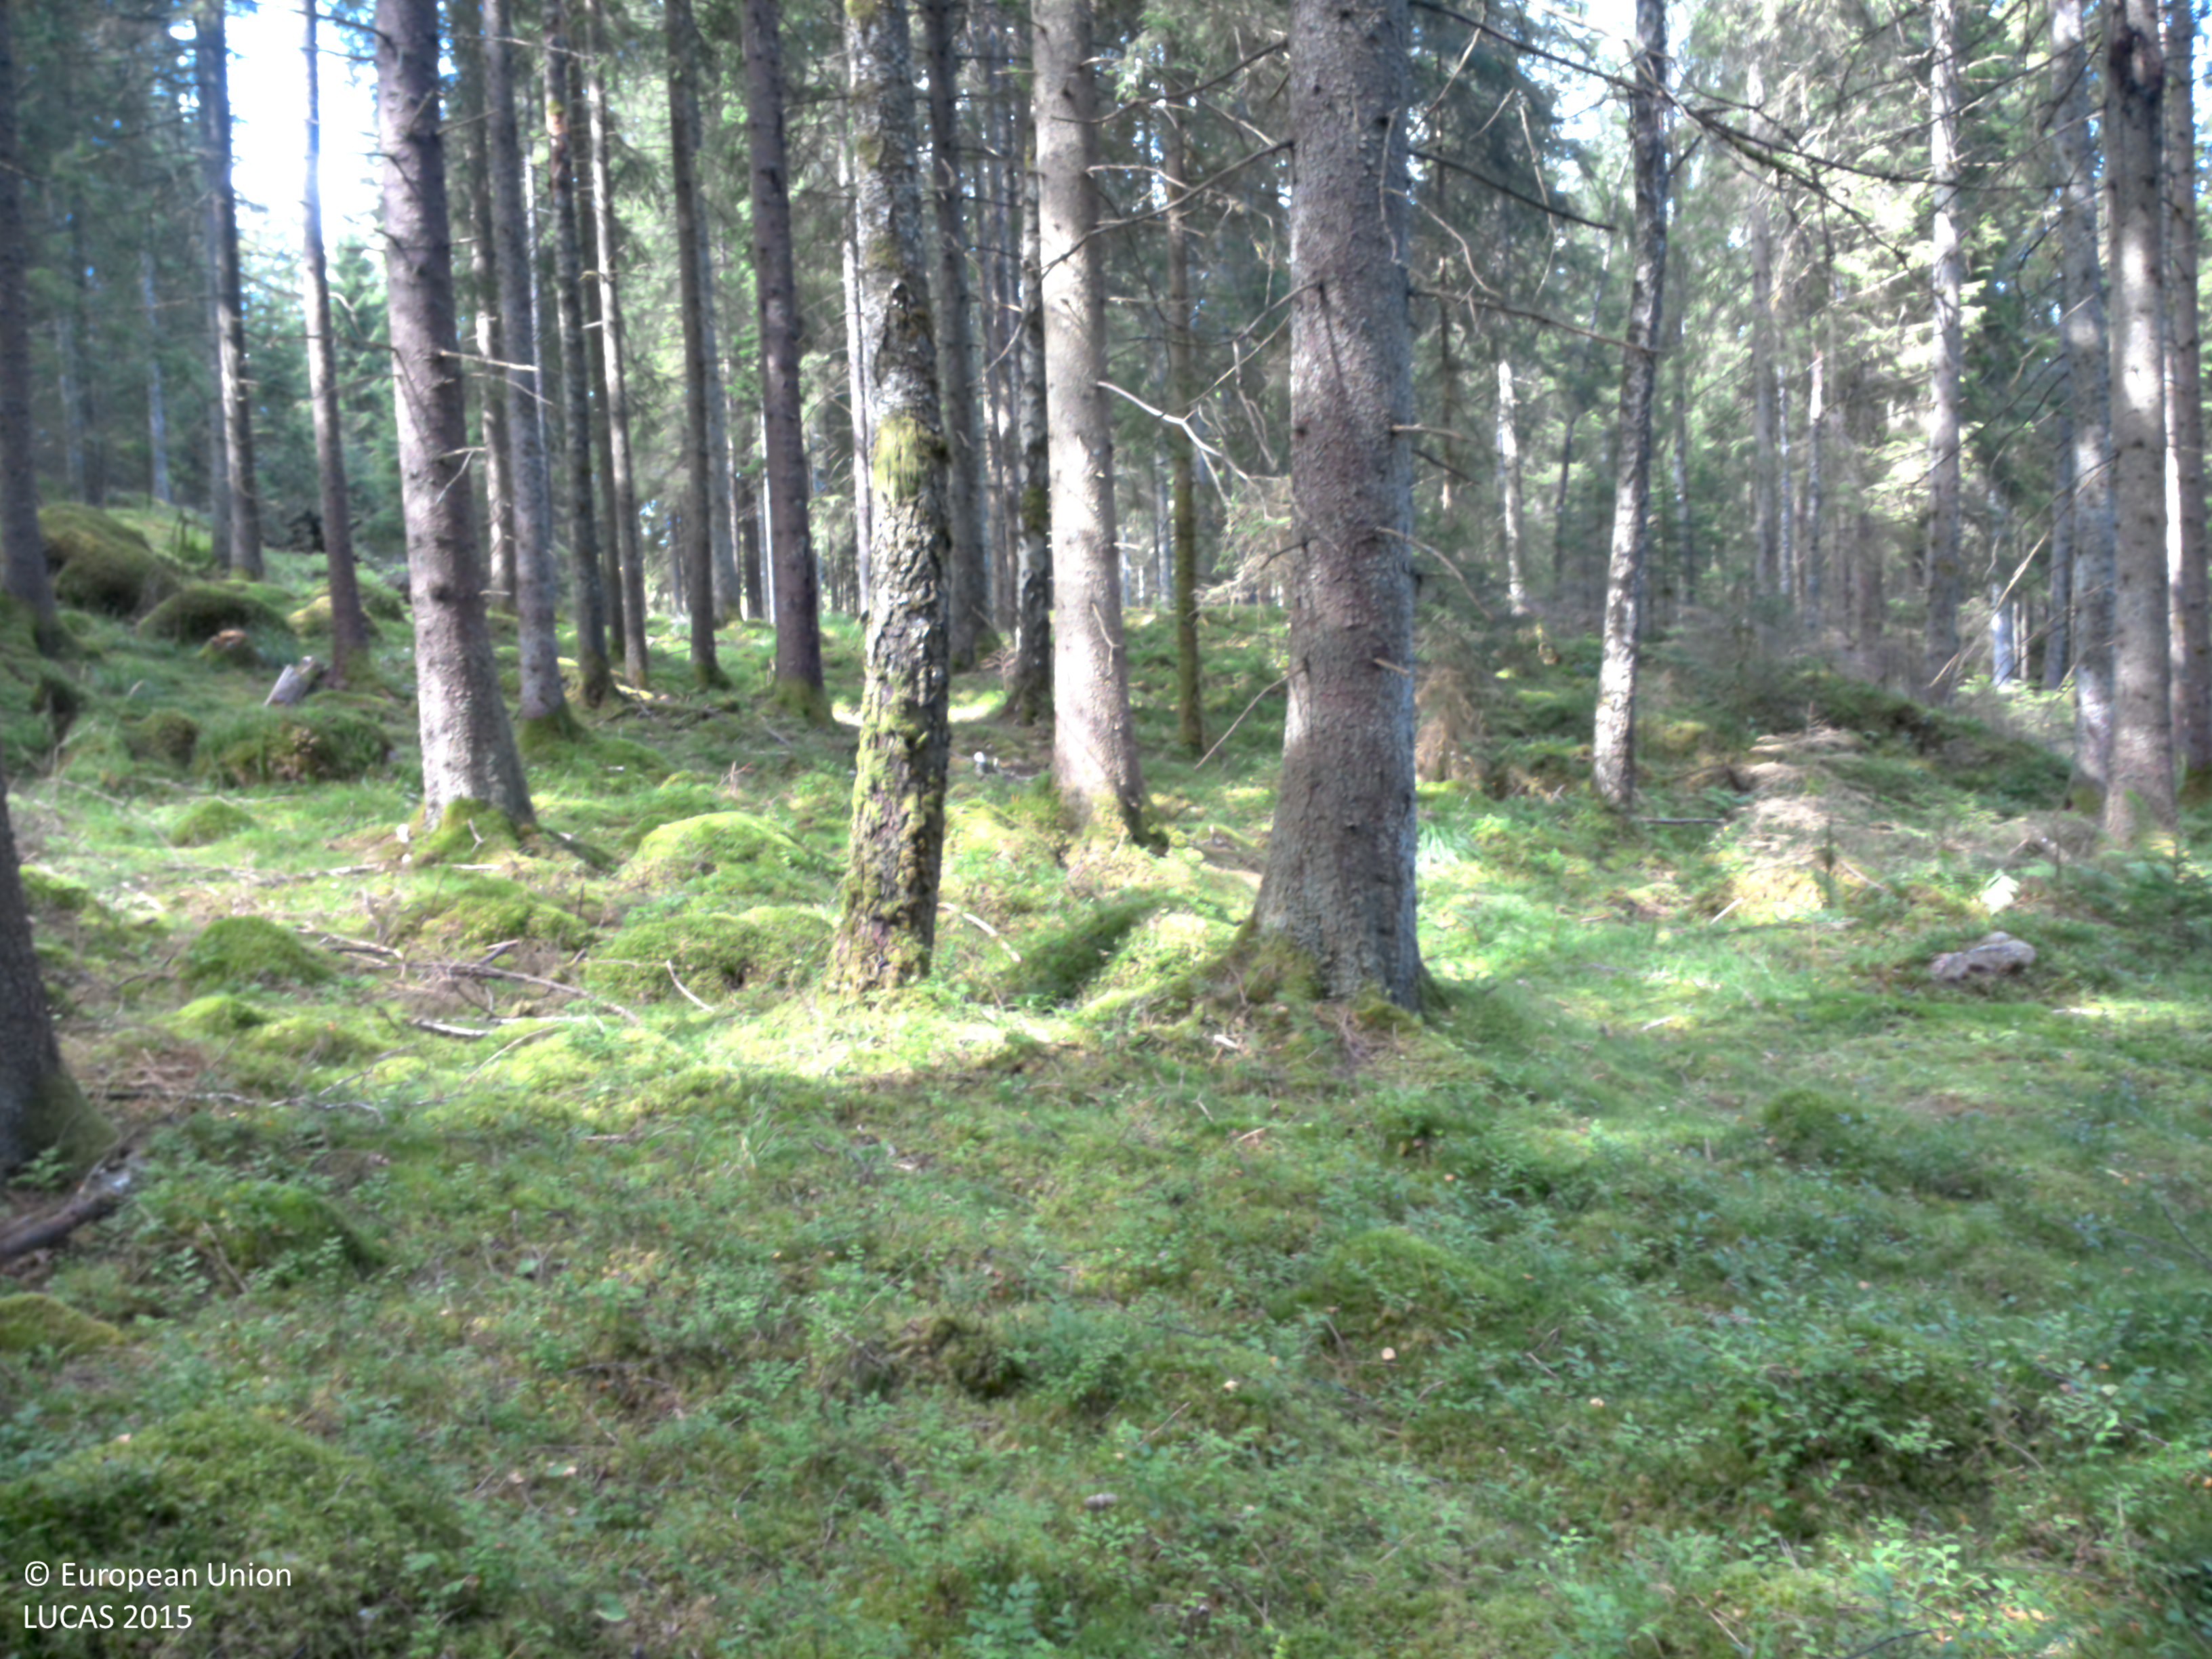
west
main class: Woodland
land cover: Spruce dominated coniferous woodland
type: boreal forest
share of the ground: 50 - 75 %
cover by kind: coniferous forest trees 60 %, lichens and mosses 30 %, shrubs 10 %
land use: Forestry
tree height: > 5 m
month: August
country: SE
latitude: 58.0017
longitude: 12.3140
